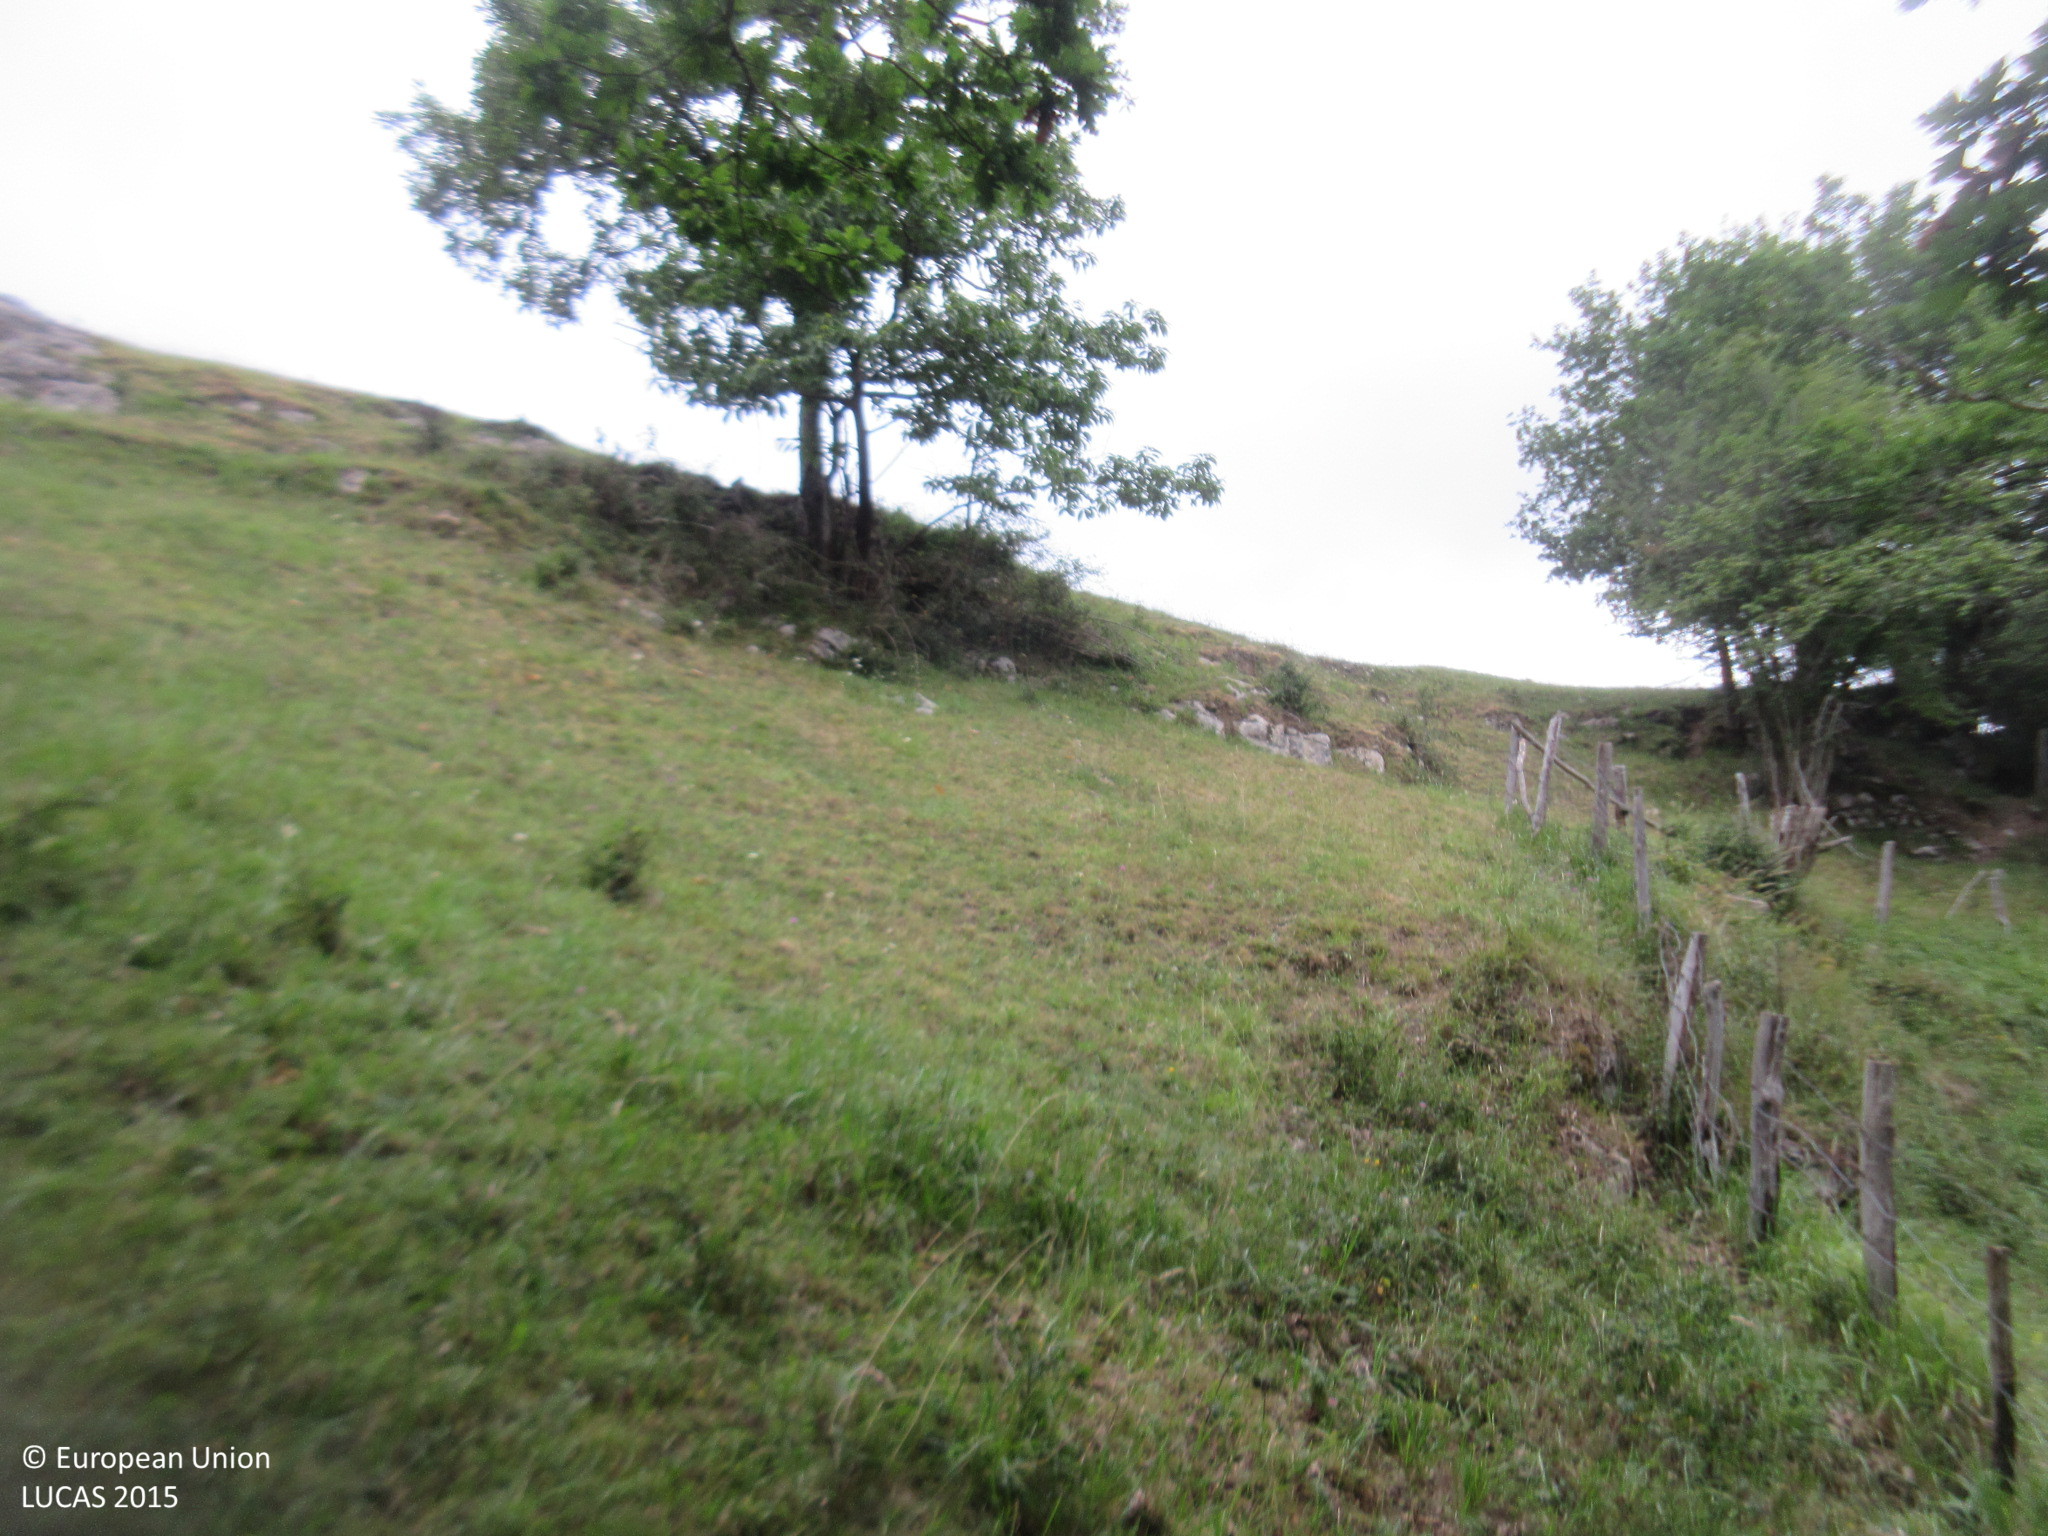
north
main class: Woodland
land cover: Pine dominated coniferous woodland
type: hemiboreal forest and nemoral coniferous forest and mixed broadleaved-coniferous forest
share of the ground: > 75 %
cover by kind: coniferous forest trees 90 %, shrubs 10 %
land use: Forestry
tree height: > 5 m
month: July
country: ES
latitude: 43.2145
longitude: -4.1220
